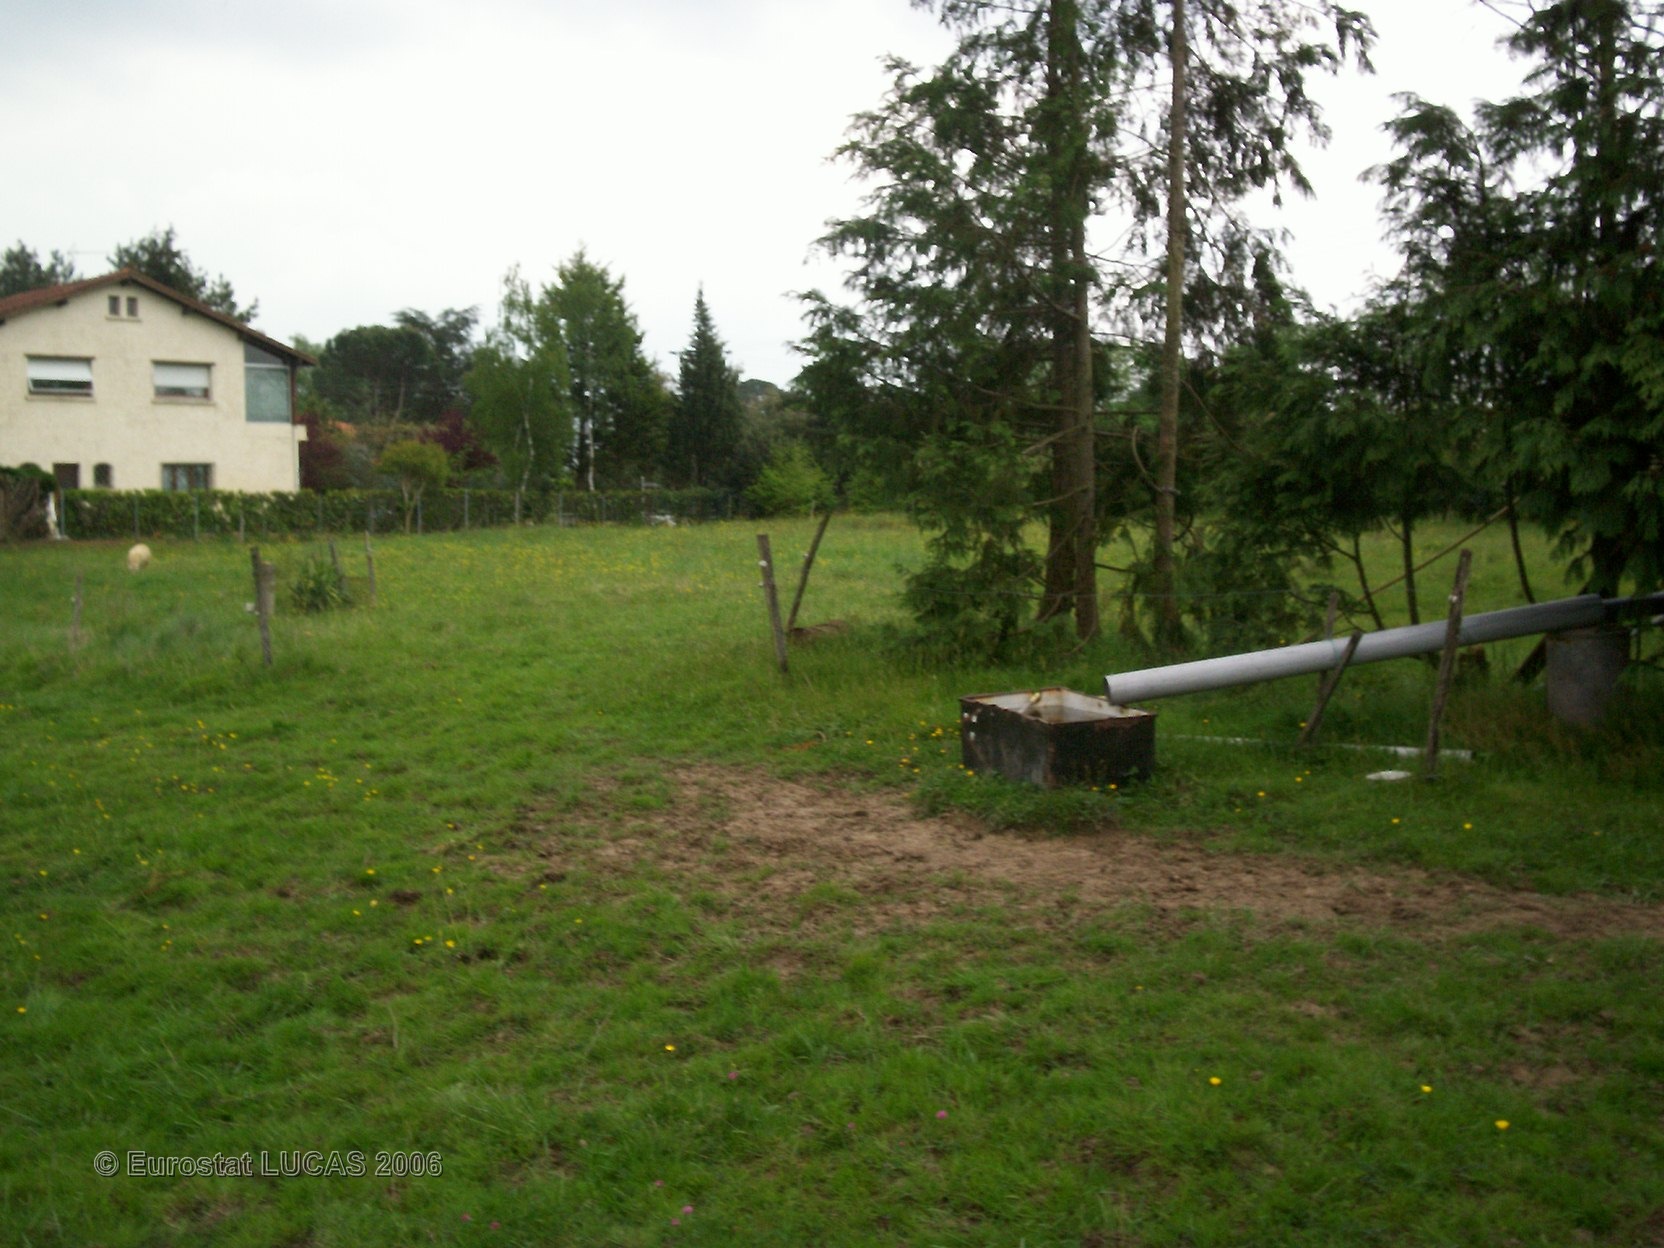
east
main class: Grassland
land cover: Grassland without tree/shrub cover
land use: Agriculture (excluding fallow land and kitchen gardens)
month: April
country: FR
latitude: 43.7147
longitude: -0.2482
